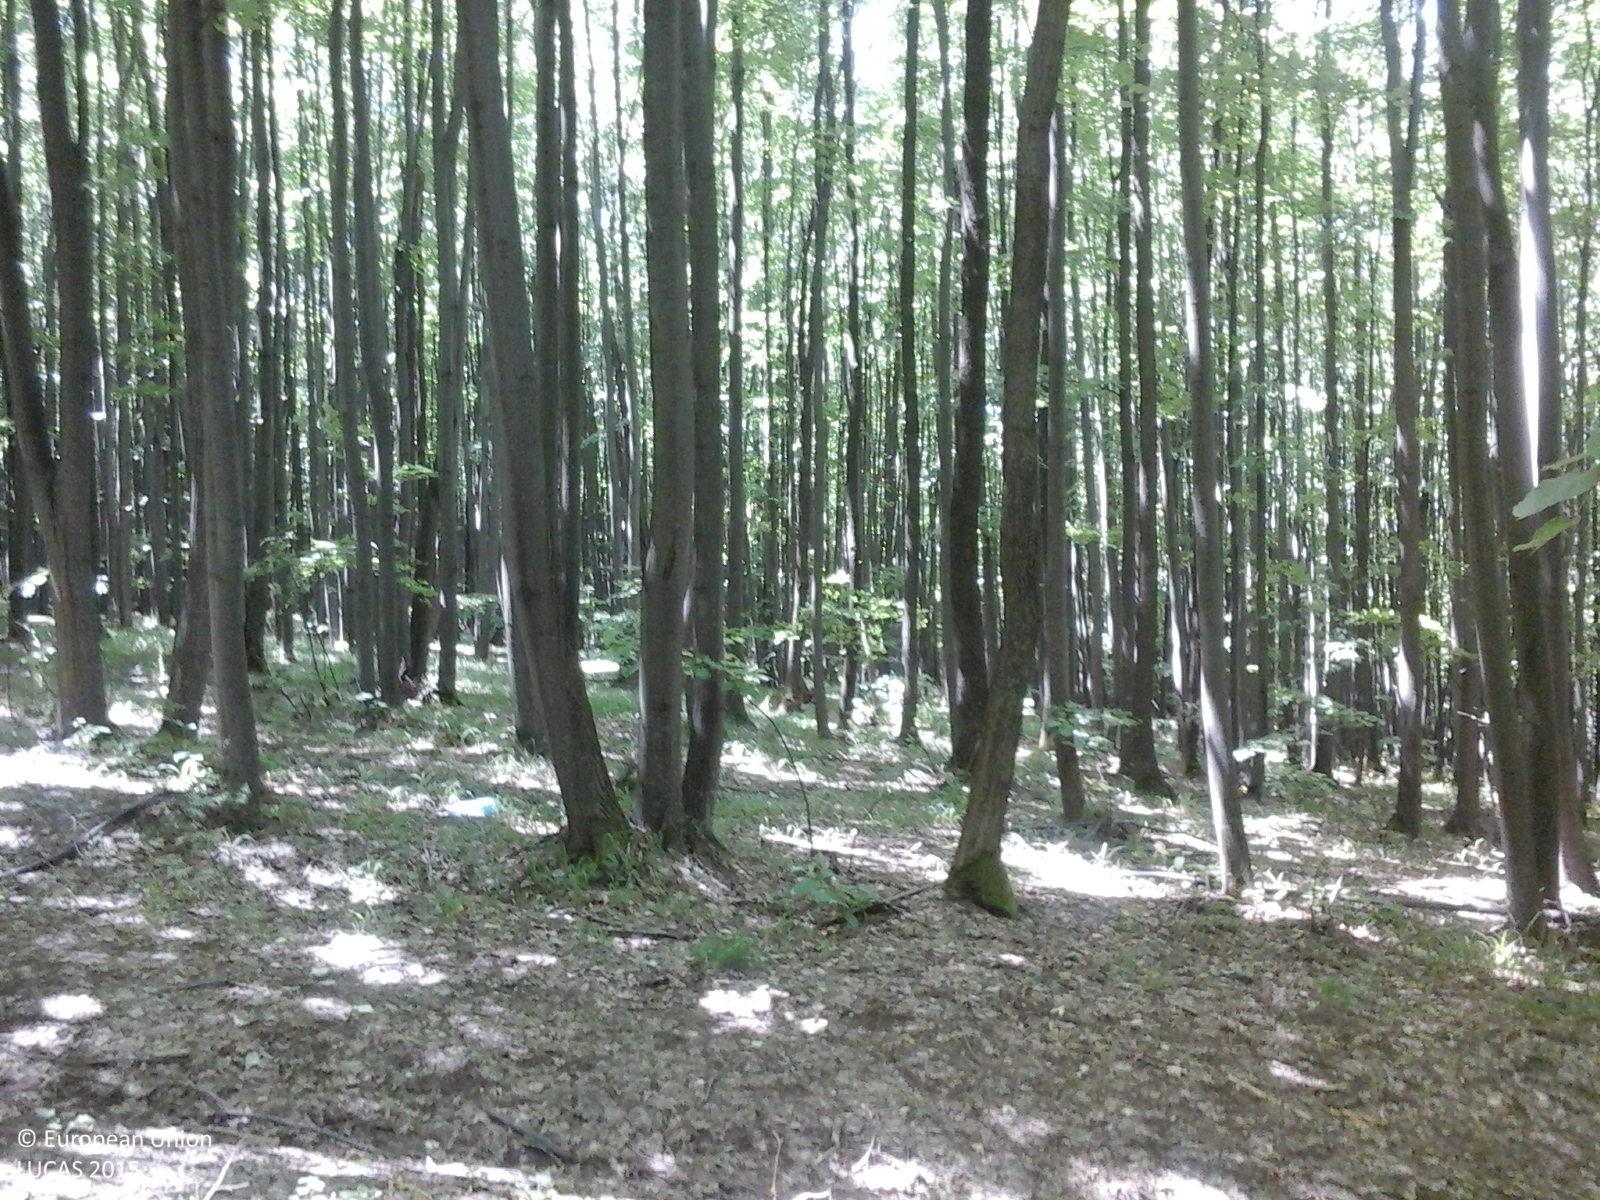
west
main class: Woodland
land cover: Broadleaved woodland
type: beech forest
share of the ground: > 75 %
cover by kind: broadleaved forest trees 95 %, herbaceous plants 5 %
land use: Forestry
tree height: > 5 m
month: June
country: RO
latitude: 45.0447
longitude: 26.1209
